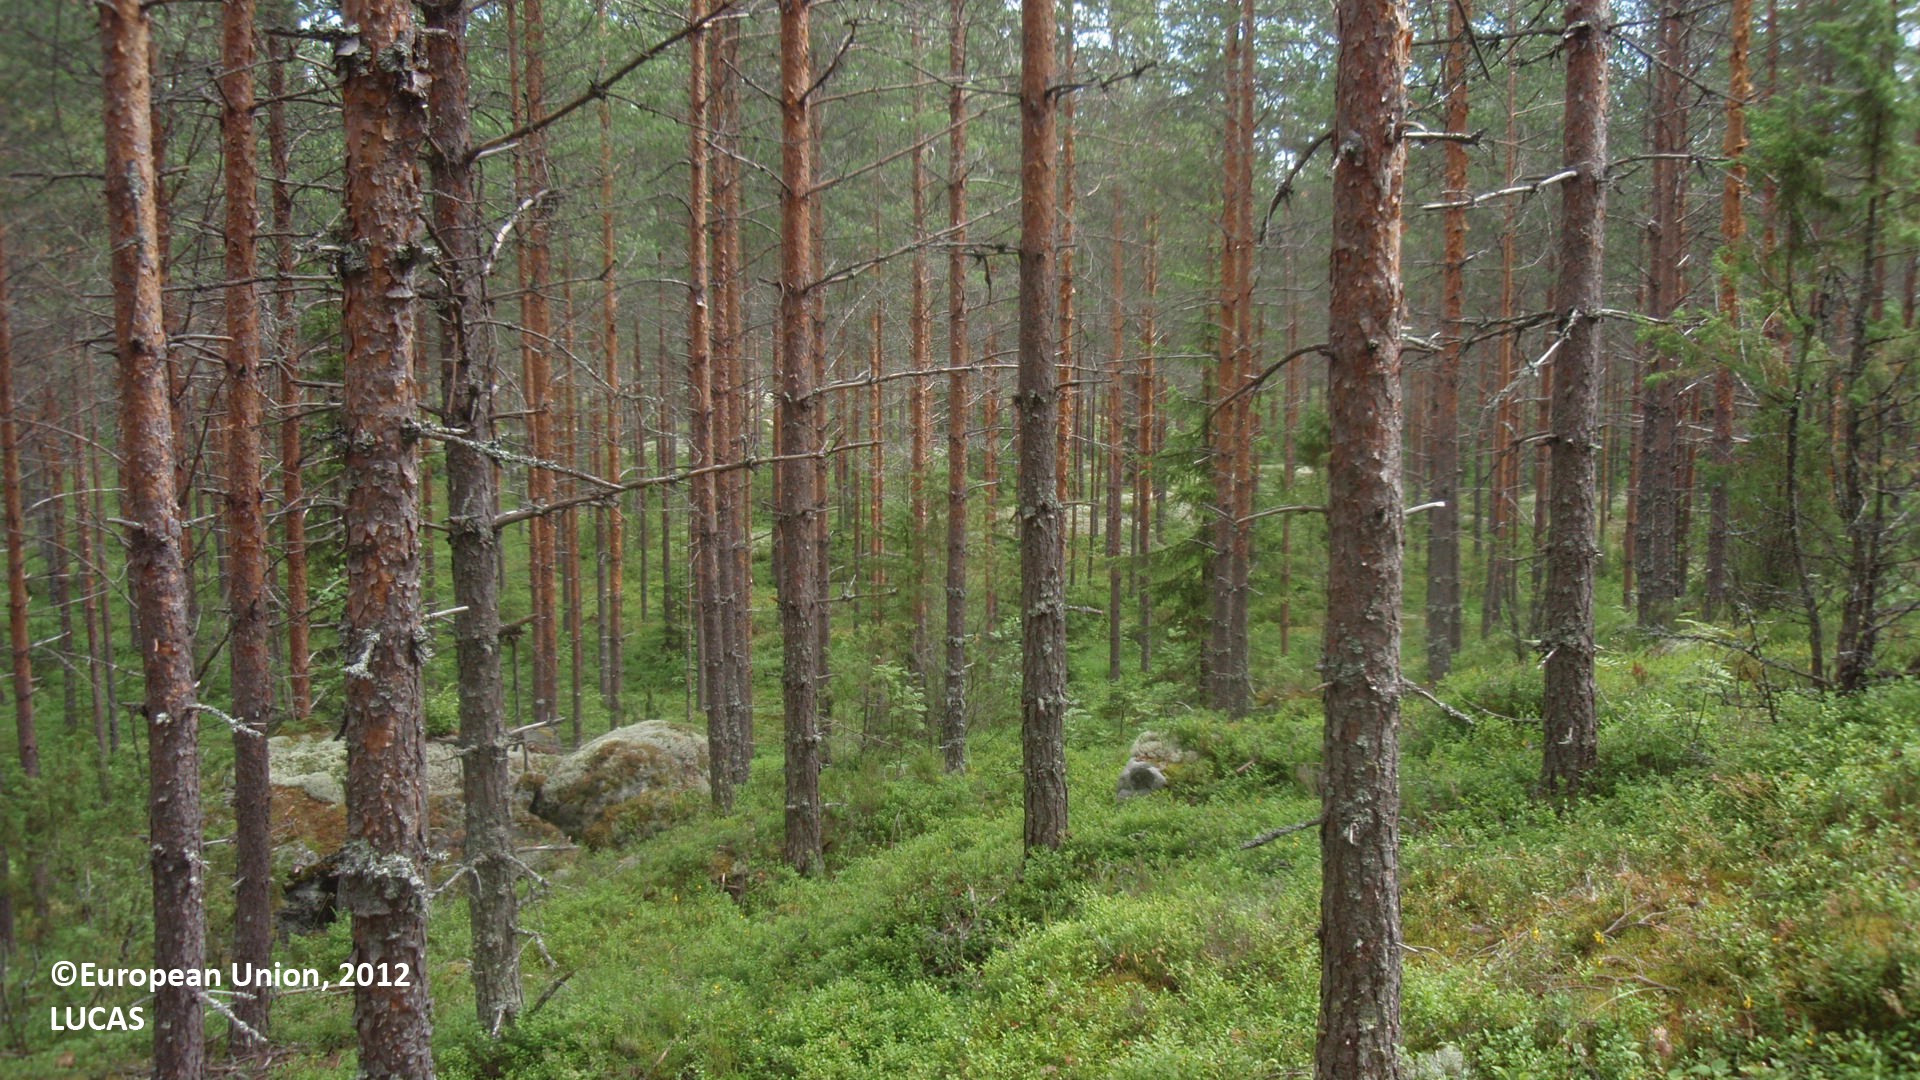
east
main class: Woodland
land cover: Pine dominated coniferous woodland
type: boreal forest
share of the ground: 50 - 75 %
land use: Forestry
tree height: > 5 m
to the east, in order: Pine dominated coniferous woodland; Grassland with sparse tree/shrub cover; Ditches and canals; Paved roads, cycling and walking lanes; Grass margins; Ditches and canals; Pine dominated coniferous woodland
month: July
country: FI
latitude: 61.4235
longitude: 28.4066
